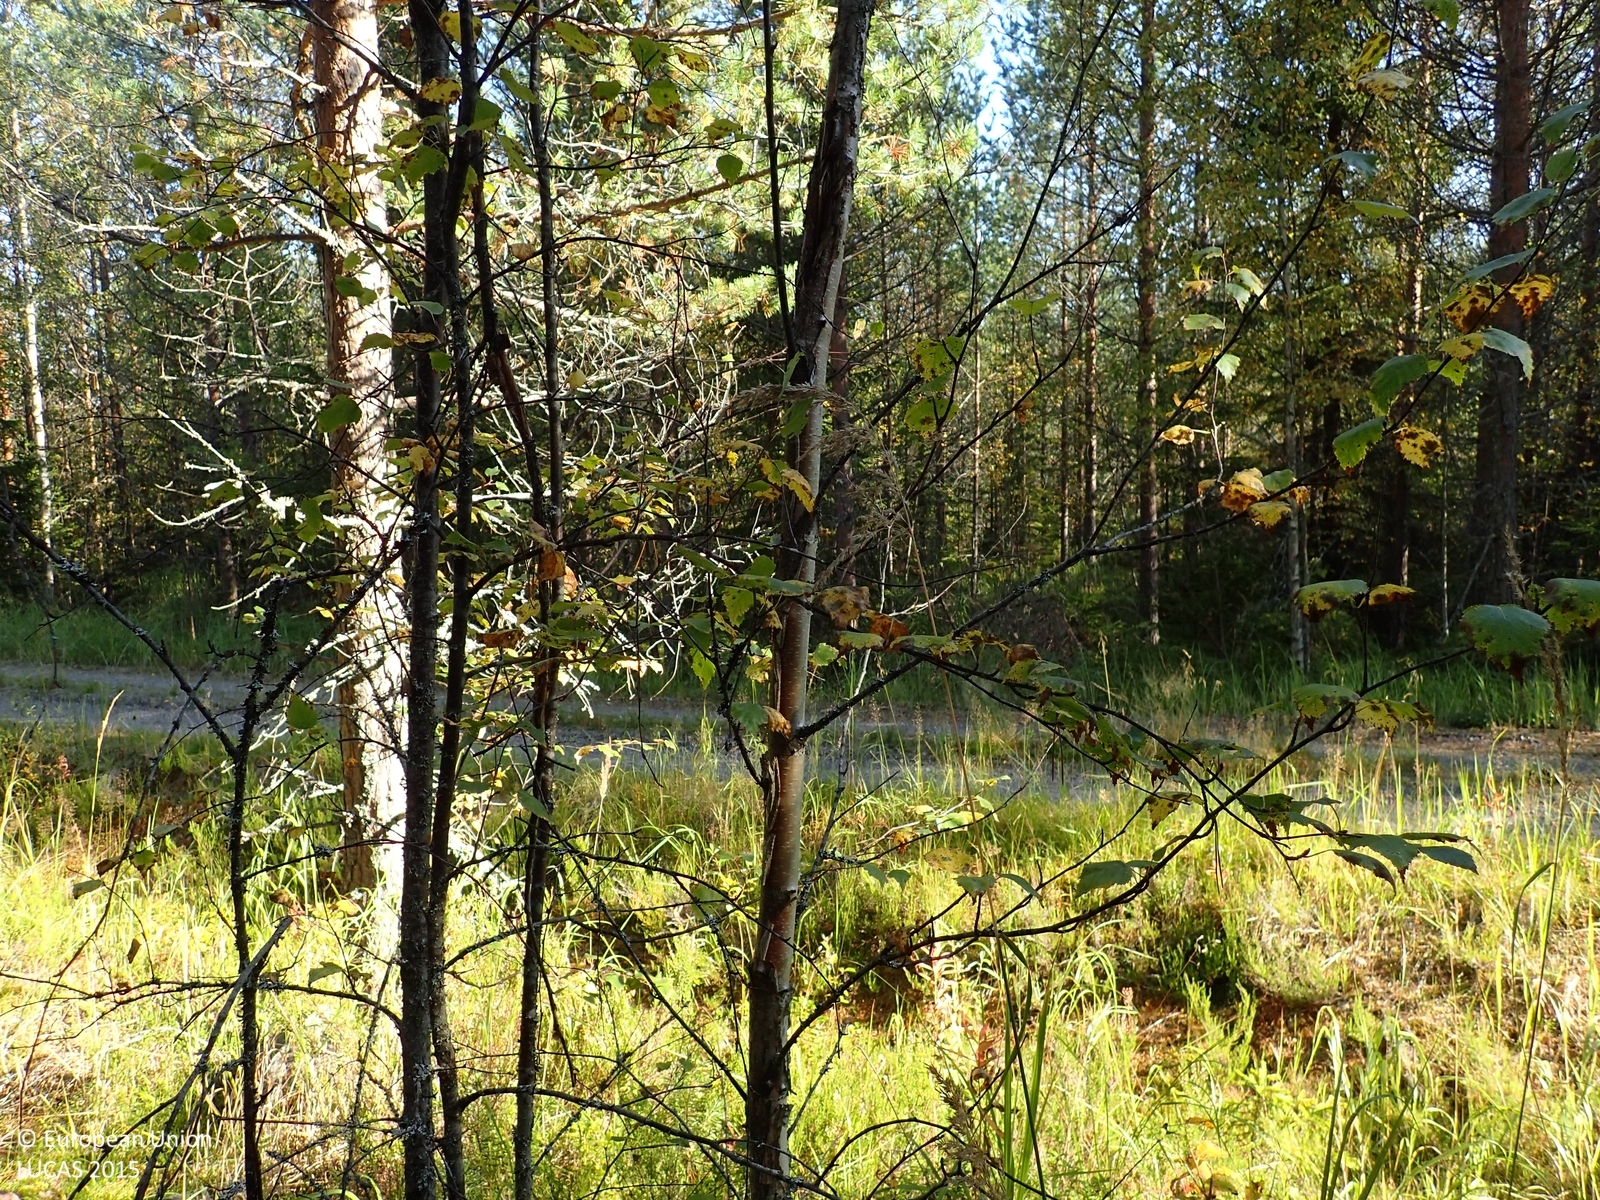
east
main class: Woodland
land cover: Pine dominated coniferous woodland
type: boreal forest
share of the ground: > 75 %
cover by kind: coniferous forest trees 80 %, shrubs 10 %, broadleaved forest trees 5 %, lichens and mosses 5 %
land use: Forestry
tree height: > 5 m
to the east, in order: Pine dominated coniferous woodland; Ditches and canals; Paved roads, cycling and walking lanes; Pine dominated coniferous woodland; Pine dominated mixed woodland; Ditches and canals; Spruce dominated mixed woodland; Ditches and canals; Spruce dominated mixed woodland; Grass margins; Tracks; Grassland with sparse tree/shrub cover; Ditches and canals; Grassland with sparse tree/shrub cover; Ditches and canals; Grassland with sparse tree/shrub cover; Ditches and canals; Spruce dominated mixed woodland; Ditches and canals; Spruce dominated mixed woodland; Ditches and canals; Spruce dominated mixed woodland
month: September
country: FI
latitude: 63.1491
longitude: 25.3221
